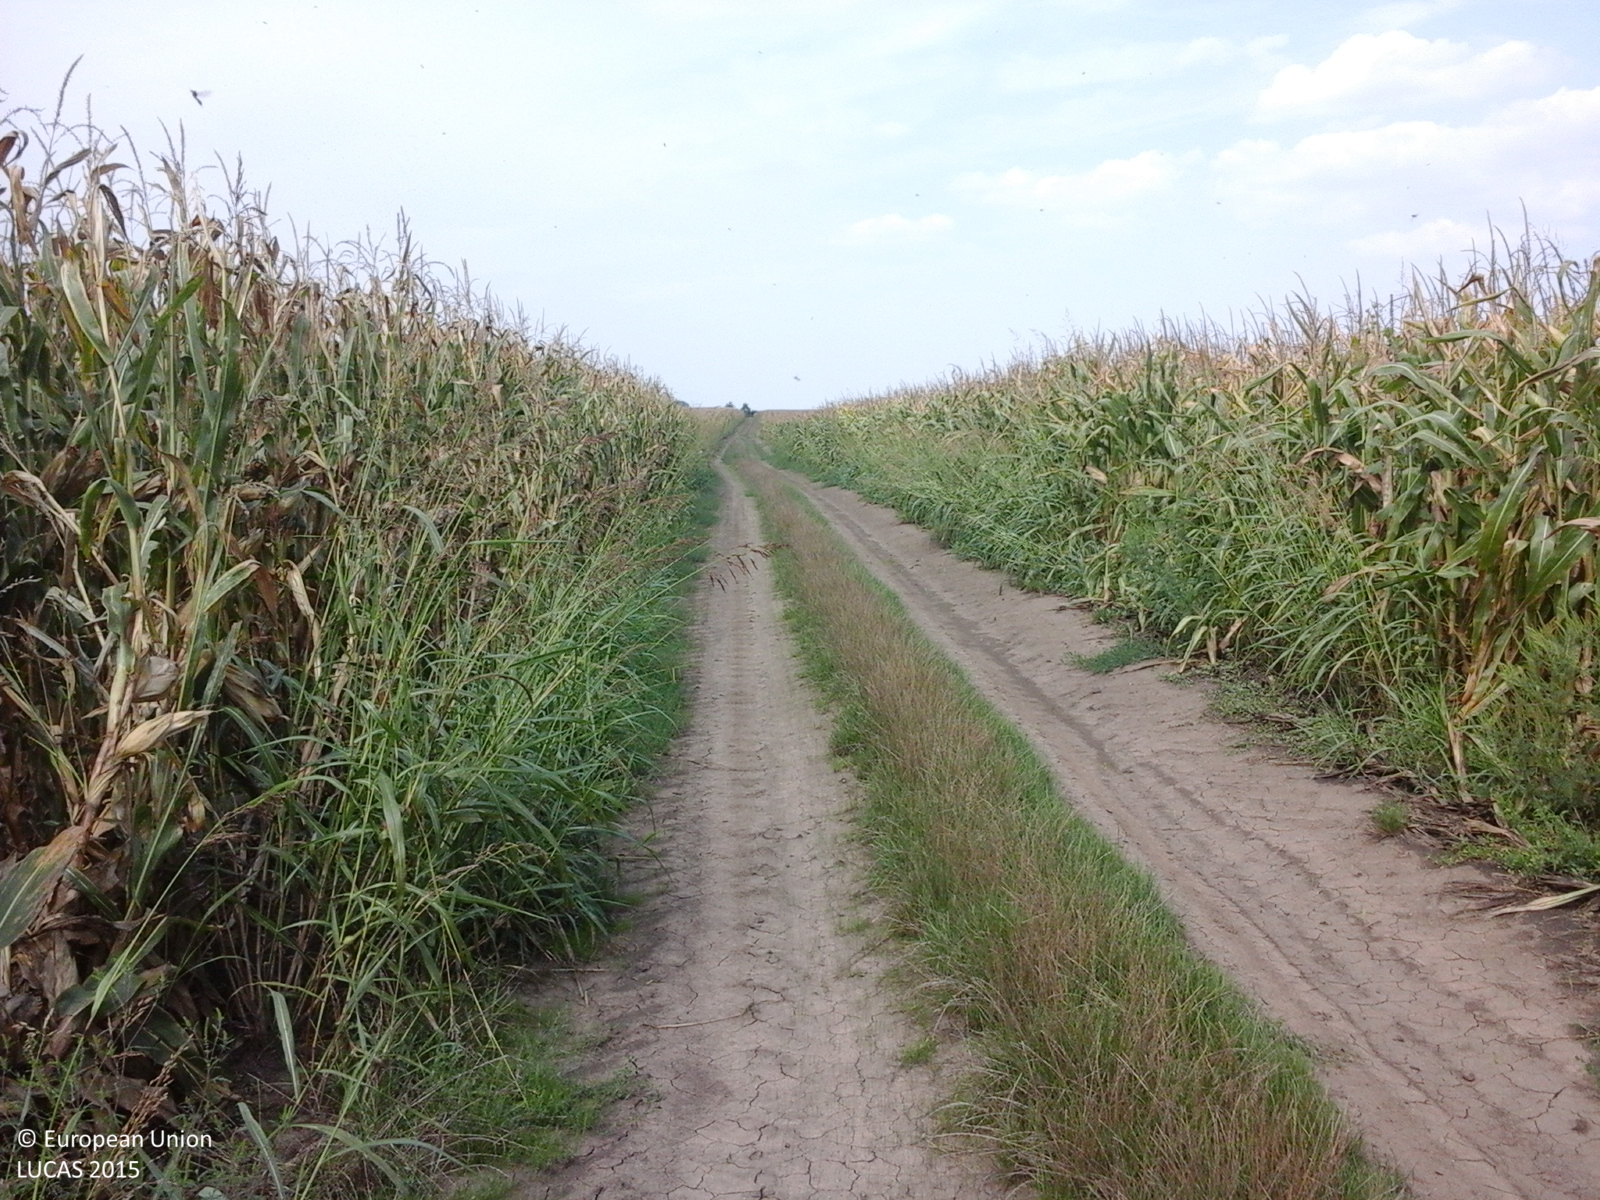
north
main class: Cropland
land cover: Maize
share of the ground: > 75 %
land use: Agriculture (excluding fallow land and kitchen gardens)
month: August
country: RO
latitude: 46.2659
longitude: 20.8893
